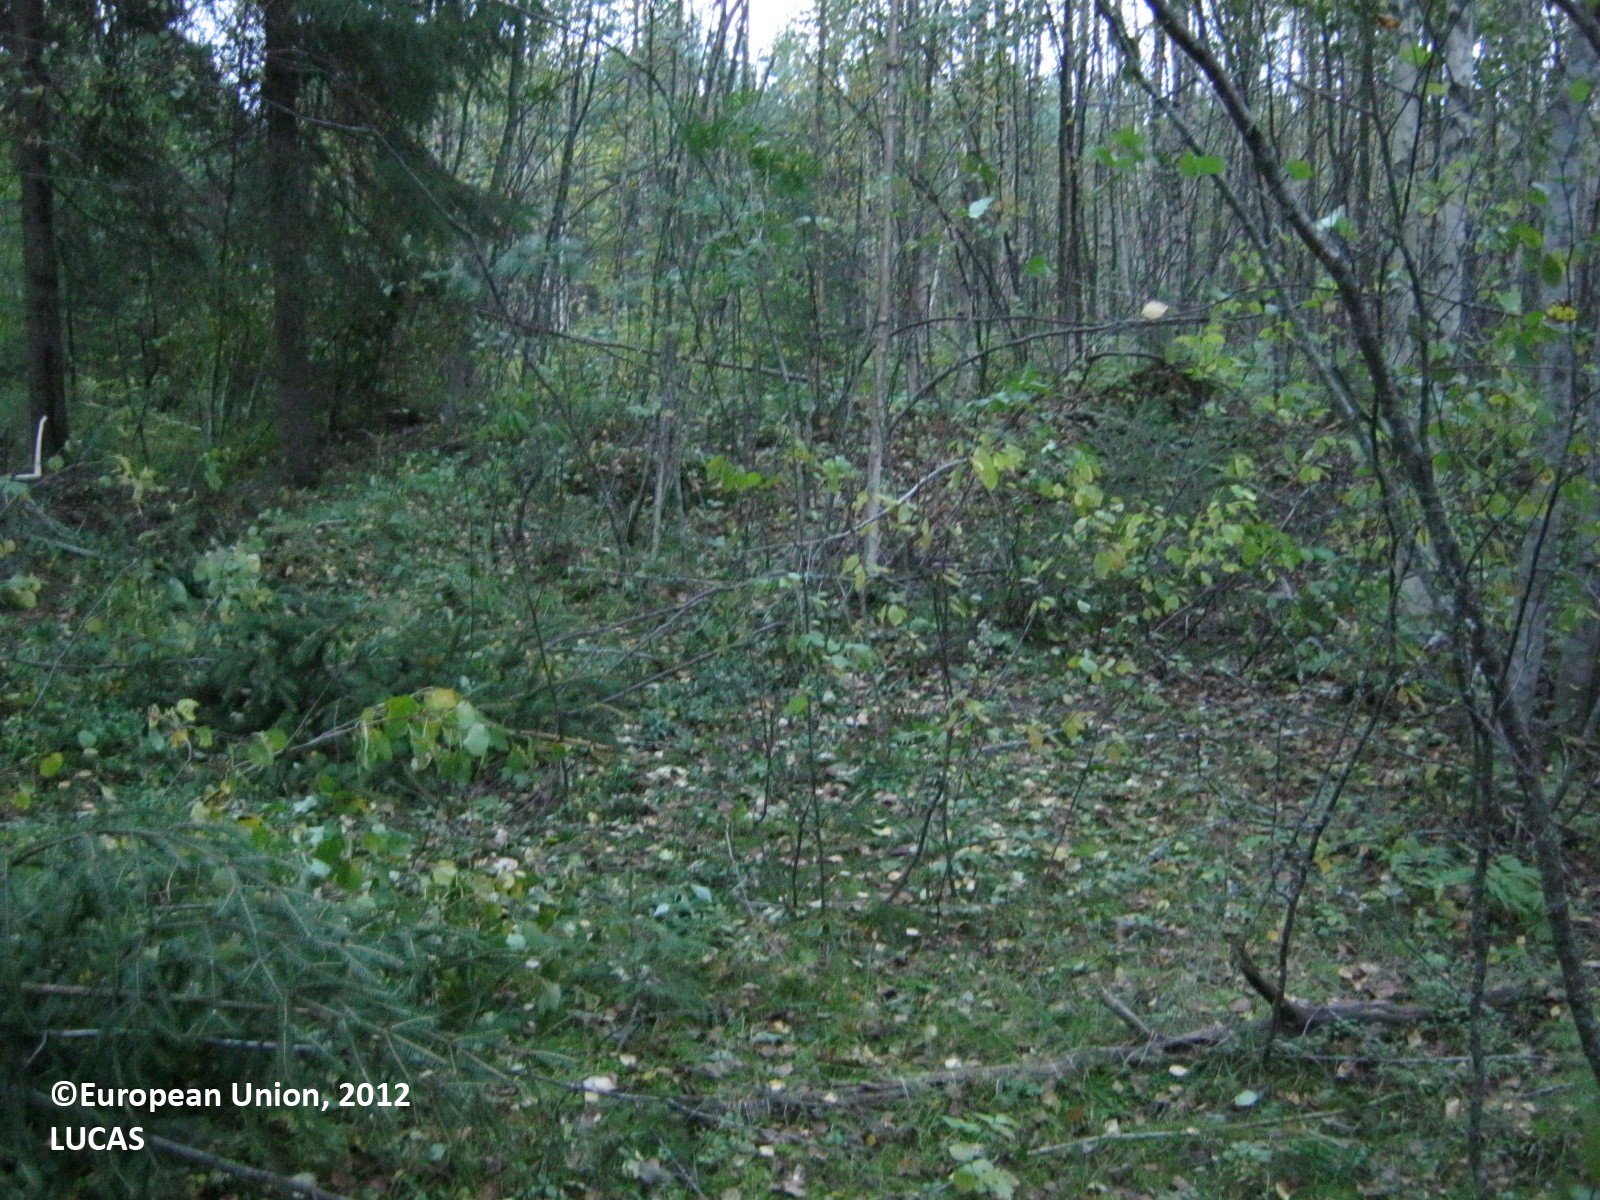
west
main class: Woodland
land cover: Broadleaved woodland
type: boreal forest
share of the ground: > 75 %
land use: Forestry
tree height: > 5 m
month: September
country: FI
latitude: 60.7275
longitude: 27.8900
